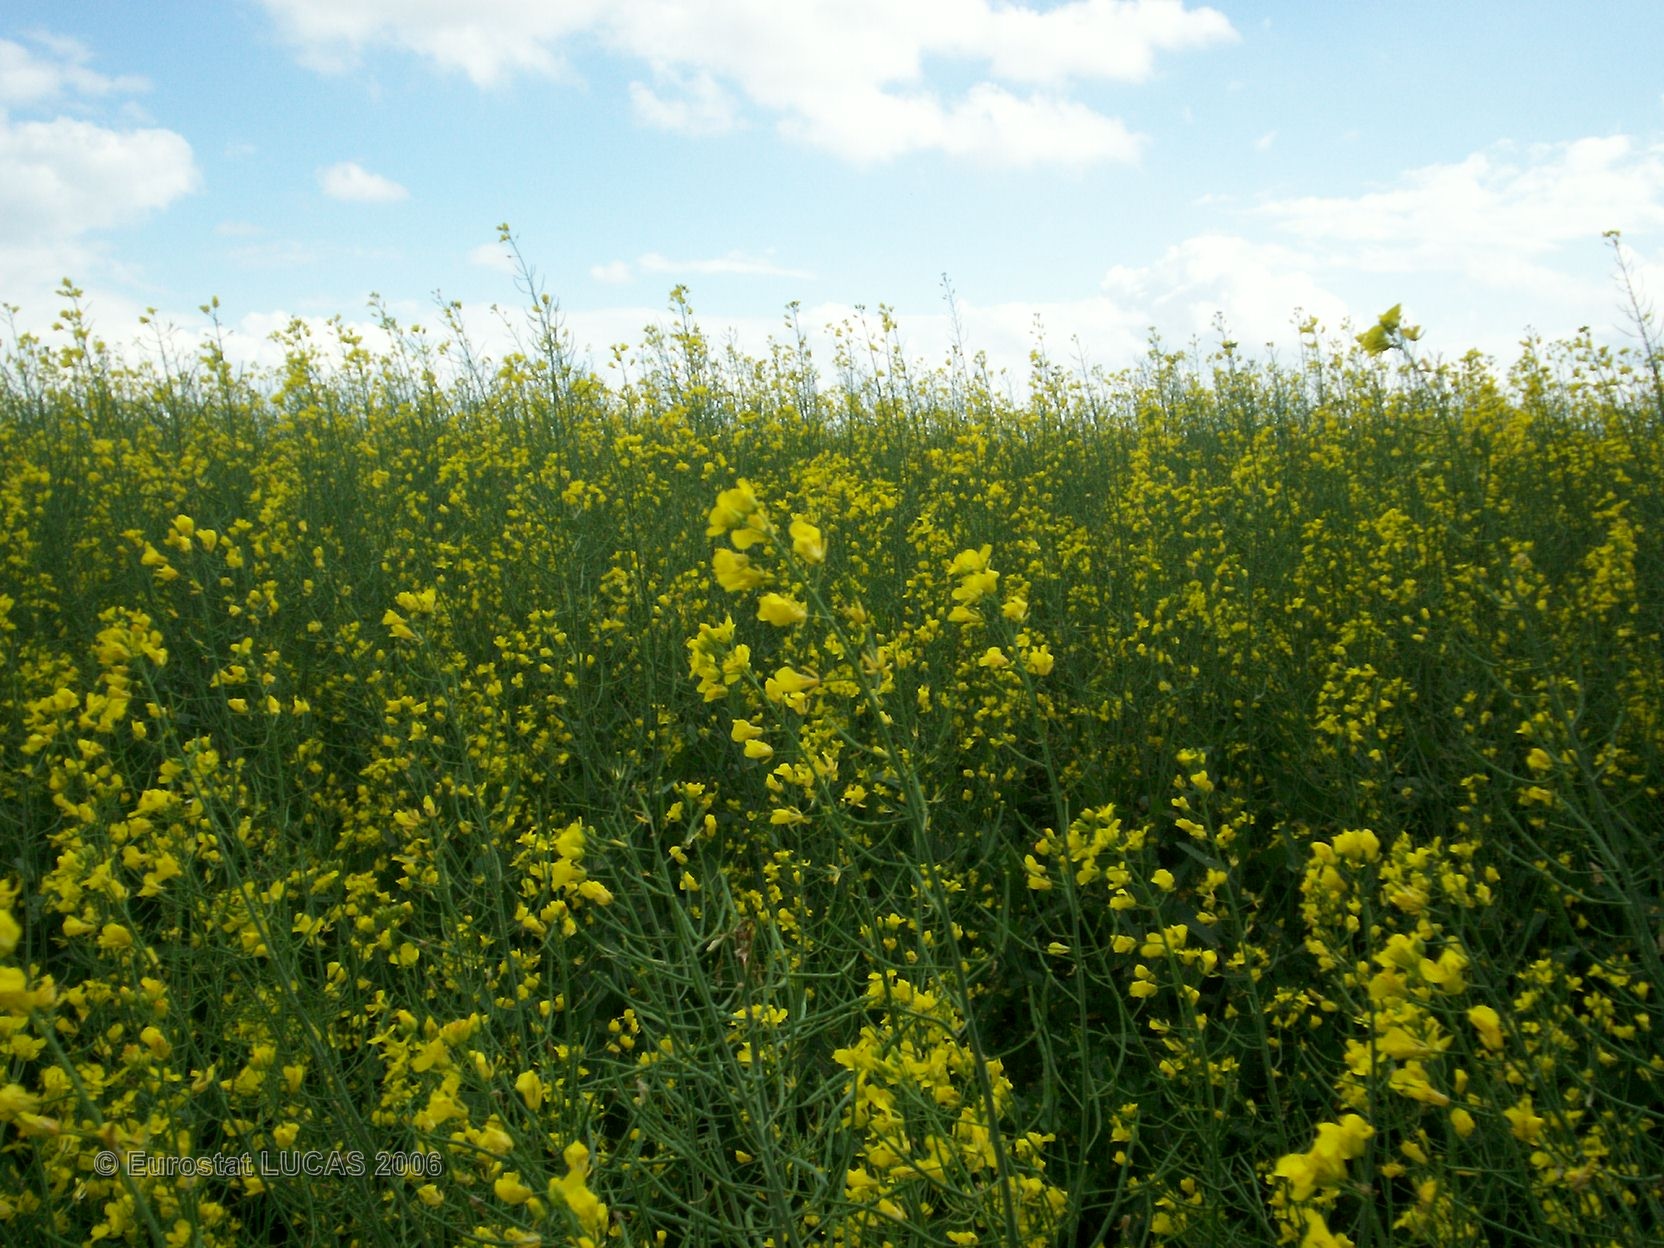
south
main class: Cropland
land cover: Rape and turnip rape
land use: Agriculture (excluding fallow land and kitchen gardens)
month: May
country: FR
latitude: 48.7625
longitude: 2.7665
